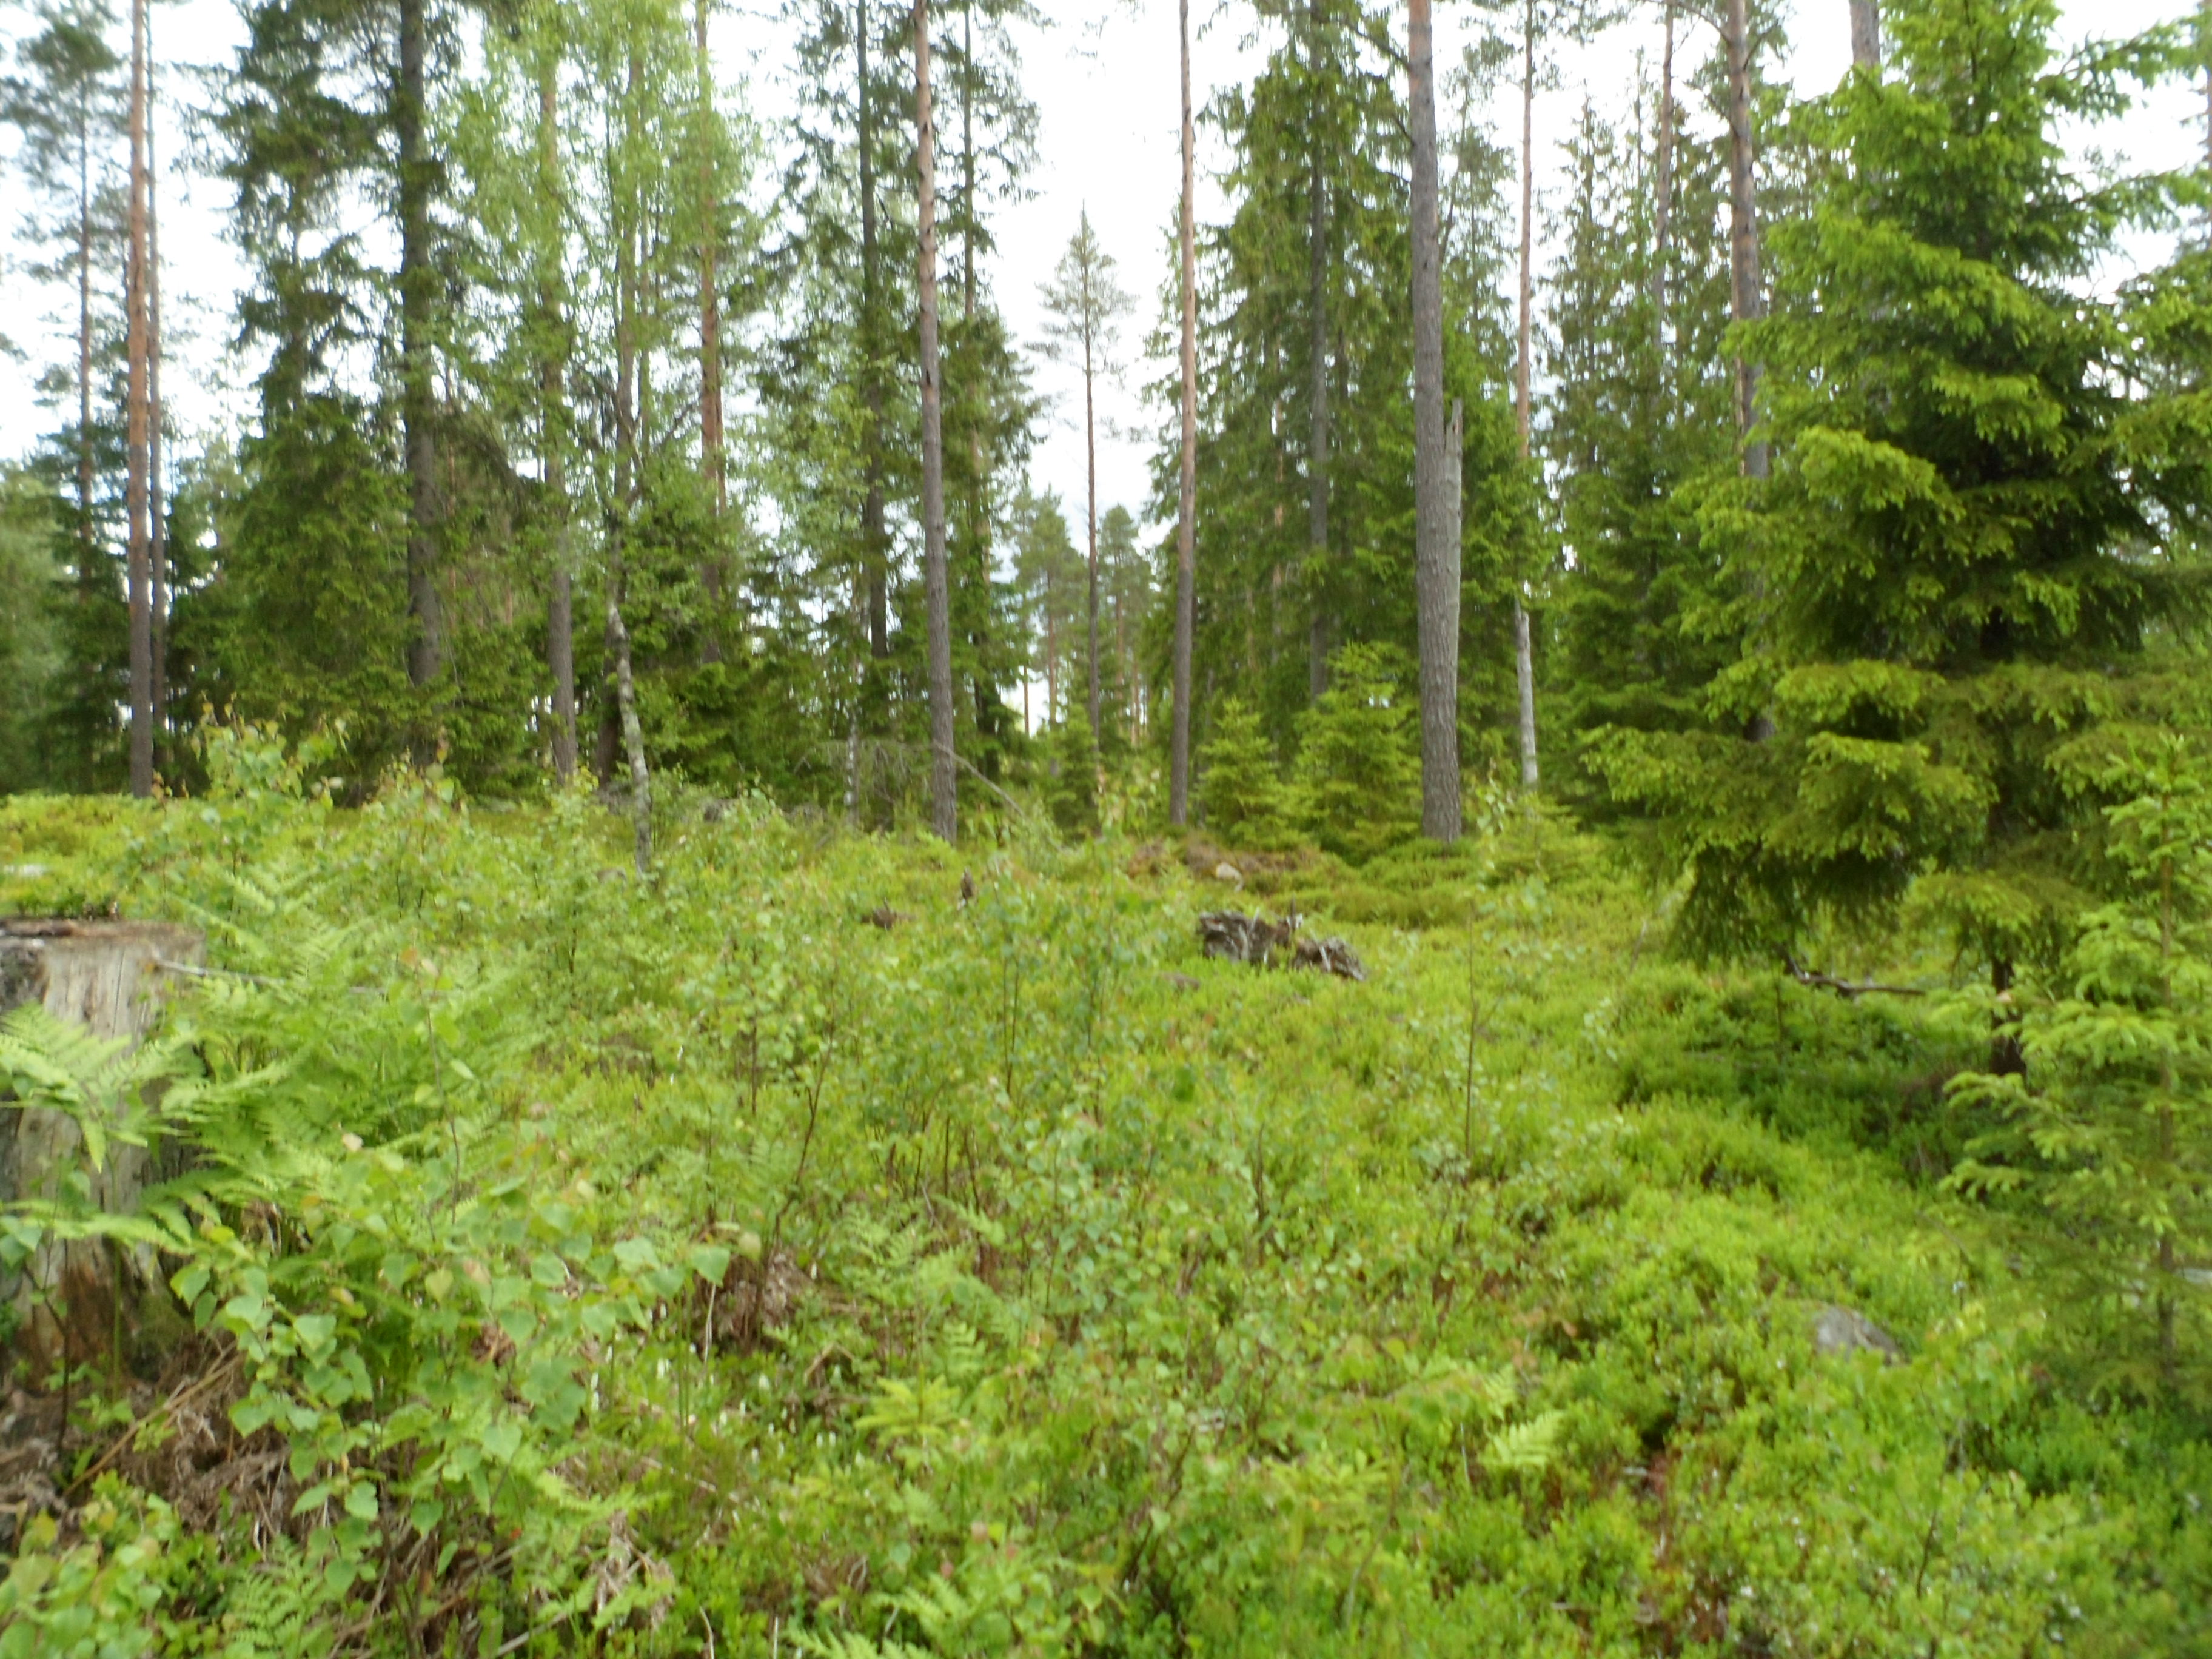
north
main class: Woodland
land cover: Pine dominated coniferous woodland
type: boreal forest
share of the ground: 25 - 50 %
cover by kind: shrubs 40 %, coniferous forest trees 30 %, lichens and mosses 20 %, broadleaved forest trees 5 %, herbaceous plants 5 %
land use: Forestry
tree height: > 5 m
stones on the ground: > 50 %
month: June
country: SE
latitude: 56.9255
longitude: 14.3177
